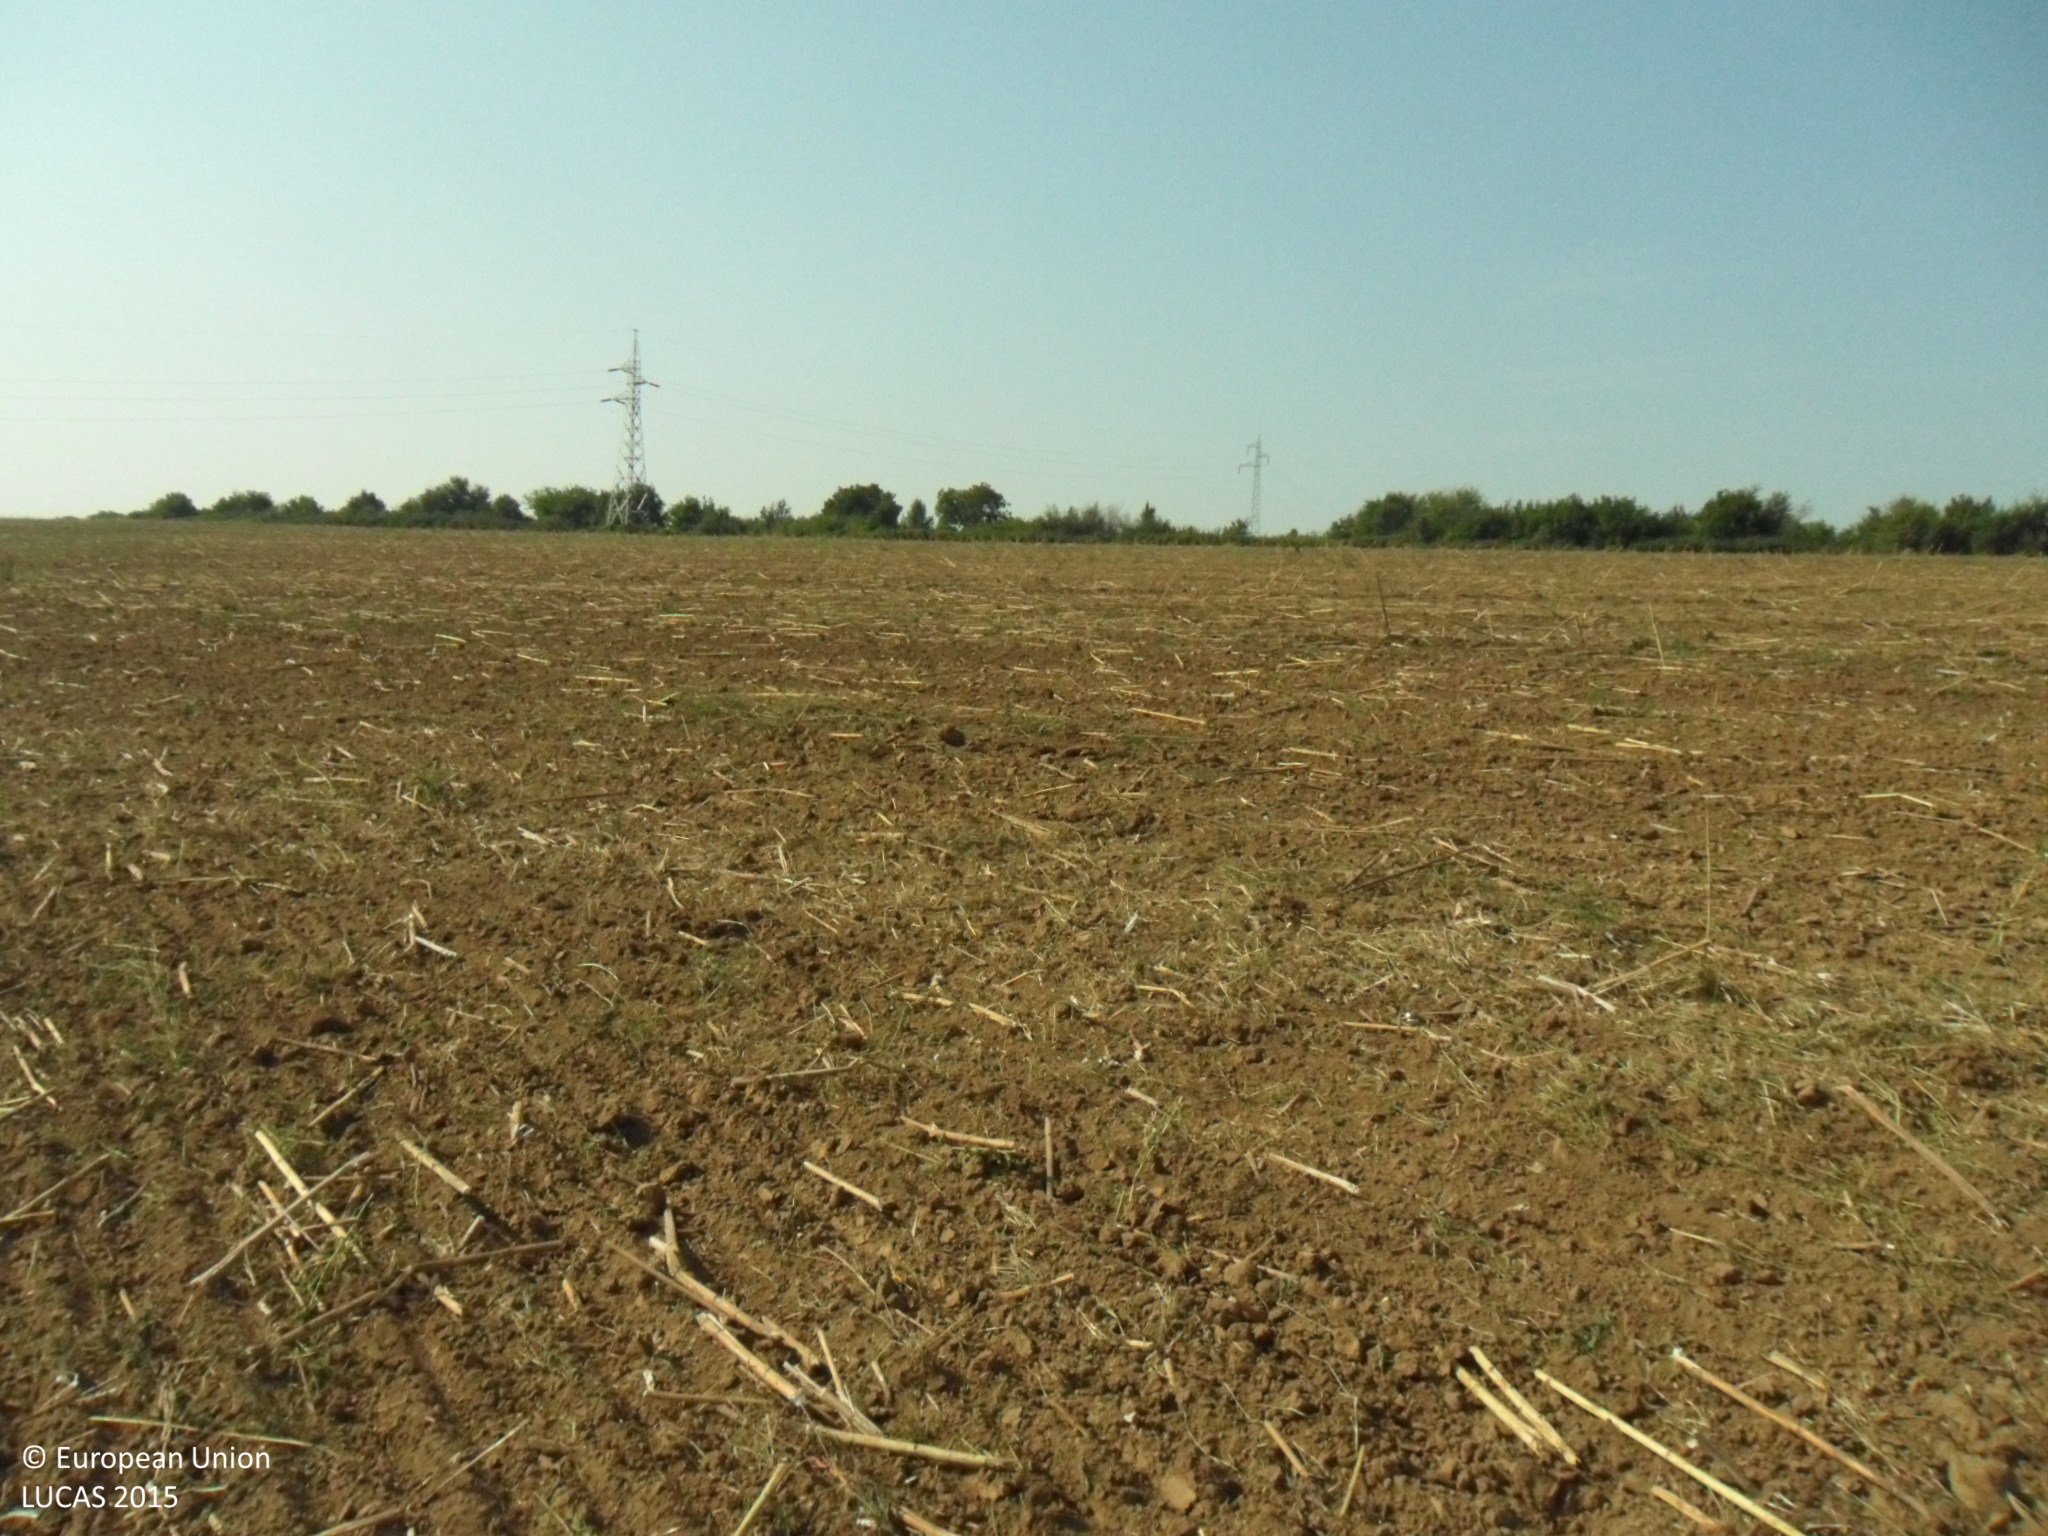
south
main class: Cropland
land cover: Sunflower
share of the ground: < 10 %
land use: Agriculture (excluding fallow land and kitchen gardens)
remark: Harvested field
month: September
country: BG
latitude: 43.6367
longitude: 26.2006
